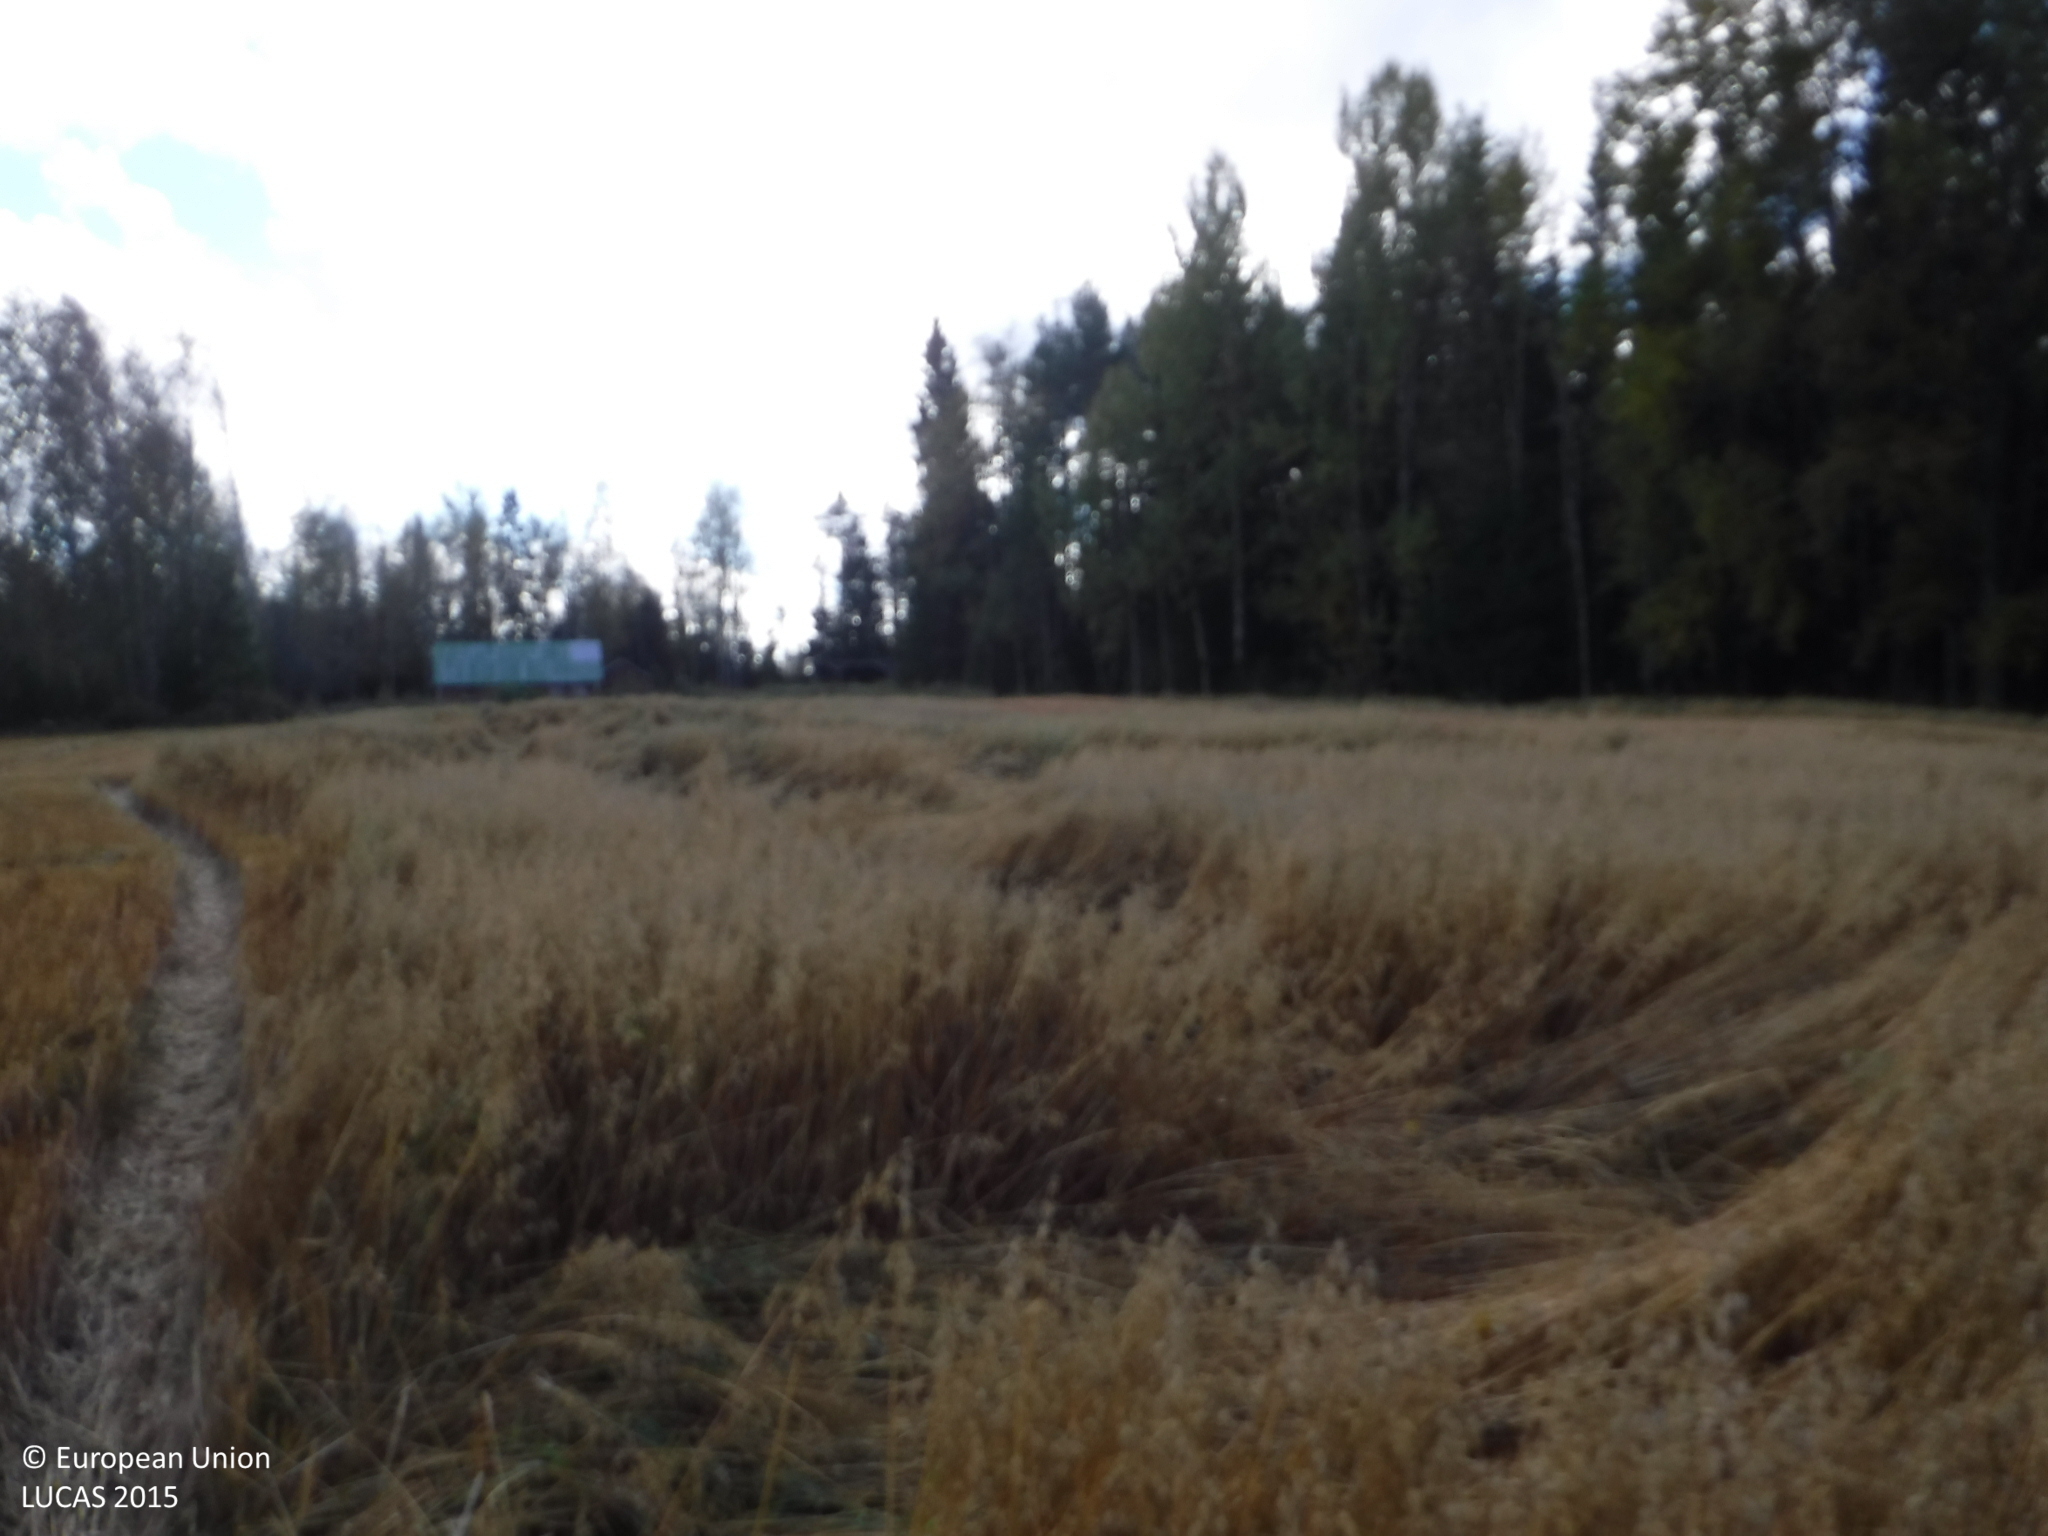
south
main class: Cropland
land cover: Oats
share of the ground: > 75 %
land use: Agriculture (excluding fallow land and kitchen gardens)
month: September
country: FI
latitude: 62.0987
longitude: 21.7146
